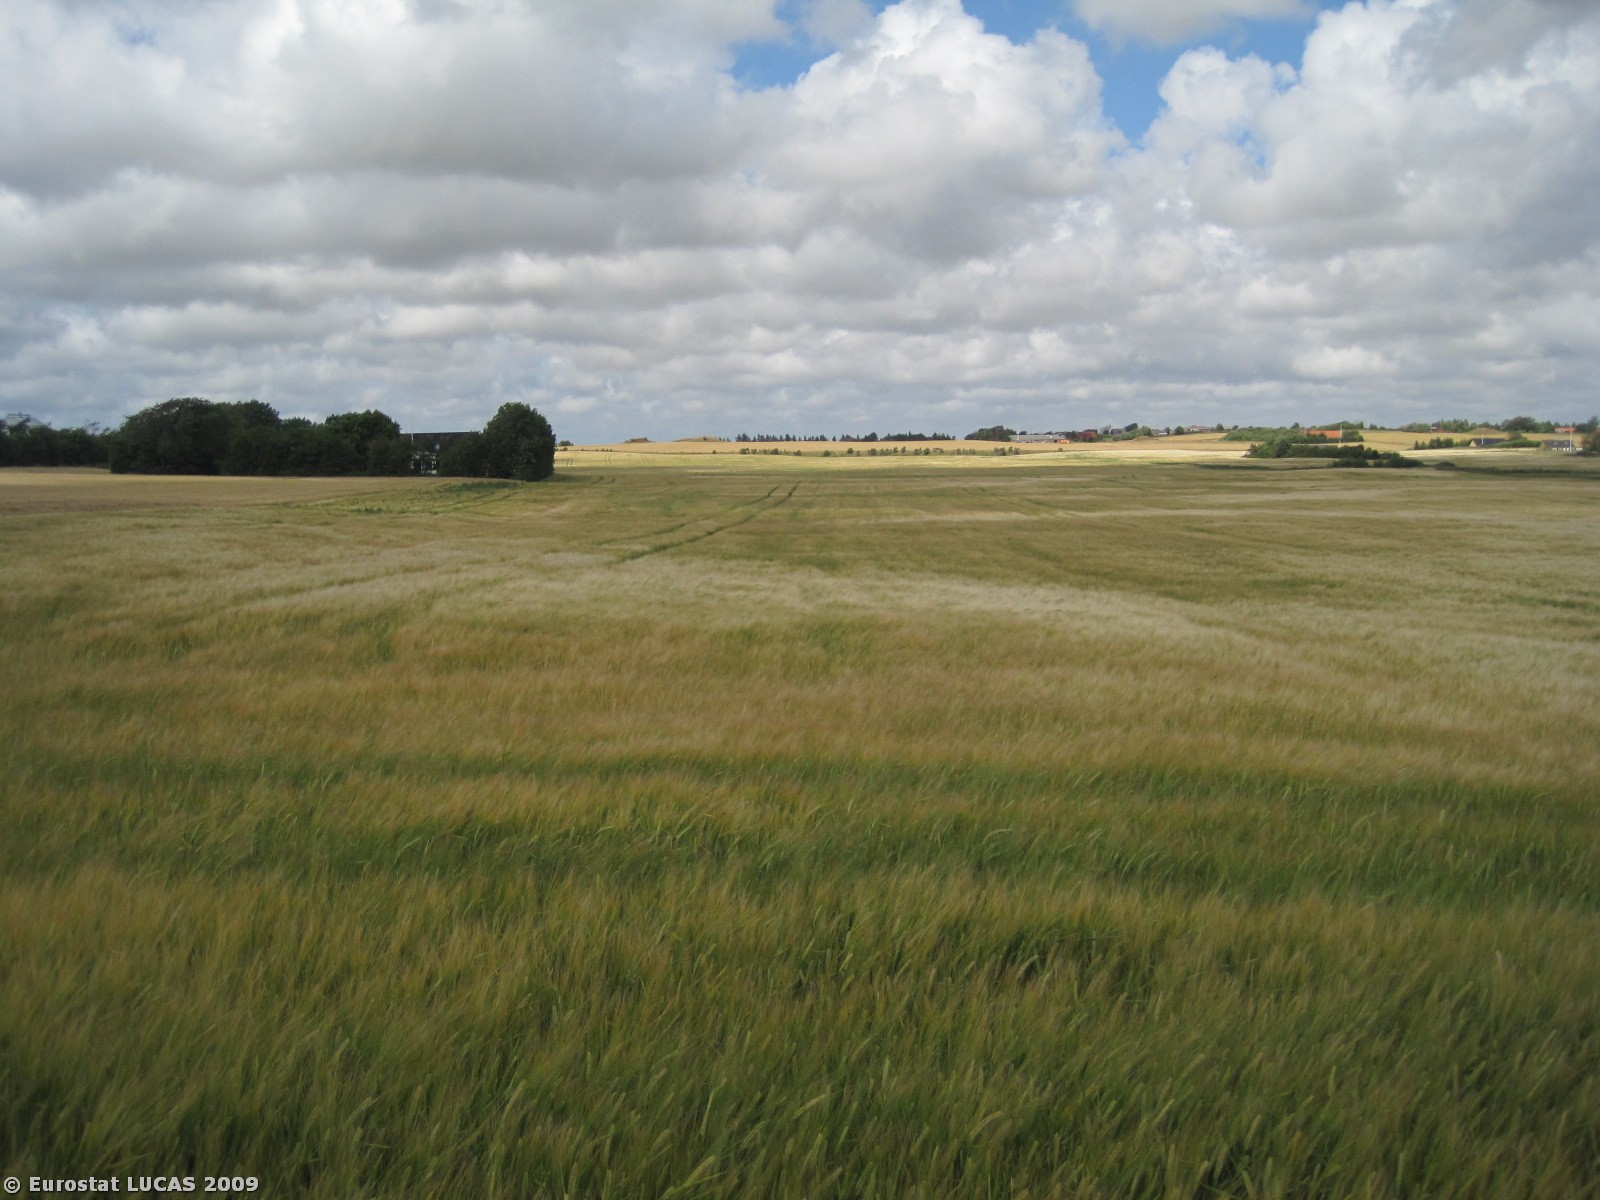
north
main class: Cropland
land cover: Barley
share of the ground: > 75 %
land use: Agriculture (excluding fallow land and kitchen gardens)
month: July
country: DK
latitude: 56.8803
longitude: 8.5088
